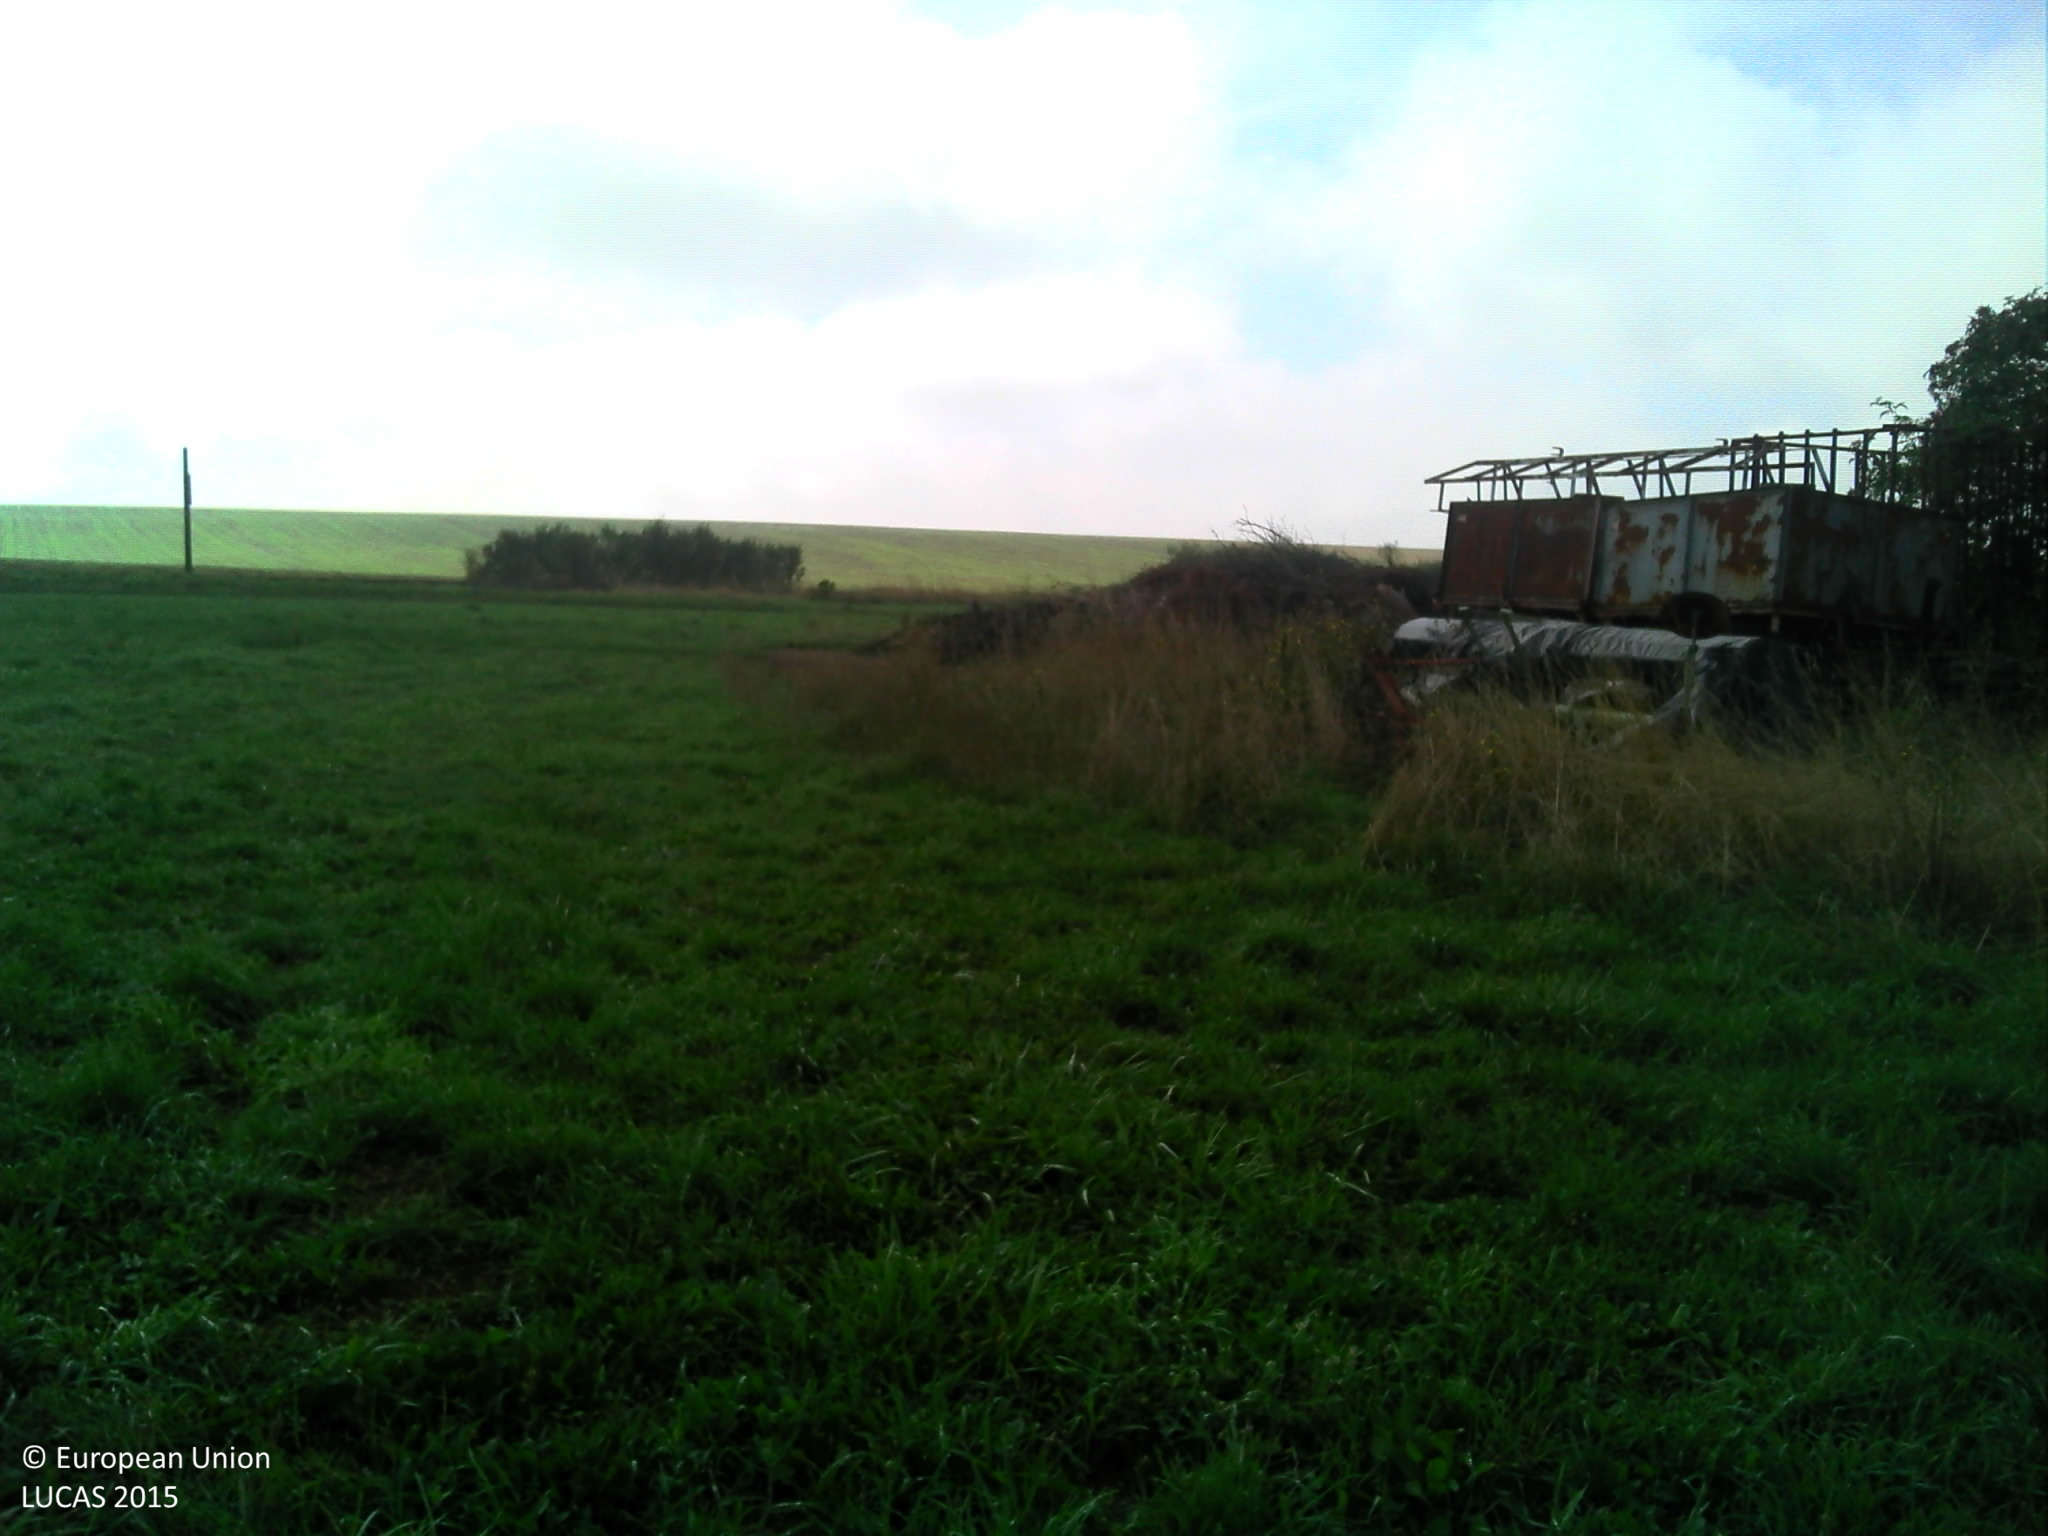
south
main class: Grassland
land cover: Grassland without tree/shrub cover
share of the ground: > 75 %
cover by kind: herbaceous plants 95 %, consolidated bare surface 5 %
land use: Agriculture (excluding fallow land and kitchen gardens)
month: September
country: FR
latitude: 49.1581
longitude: 5.9543
